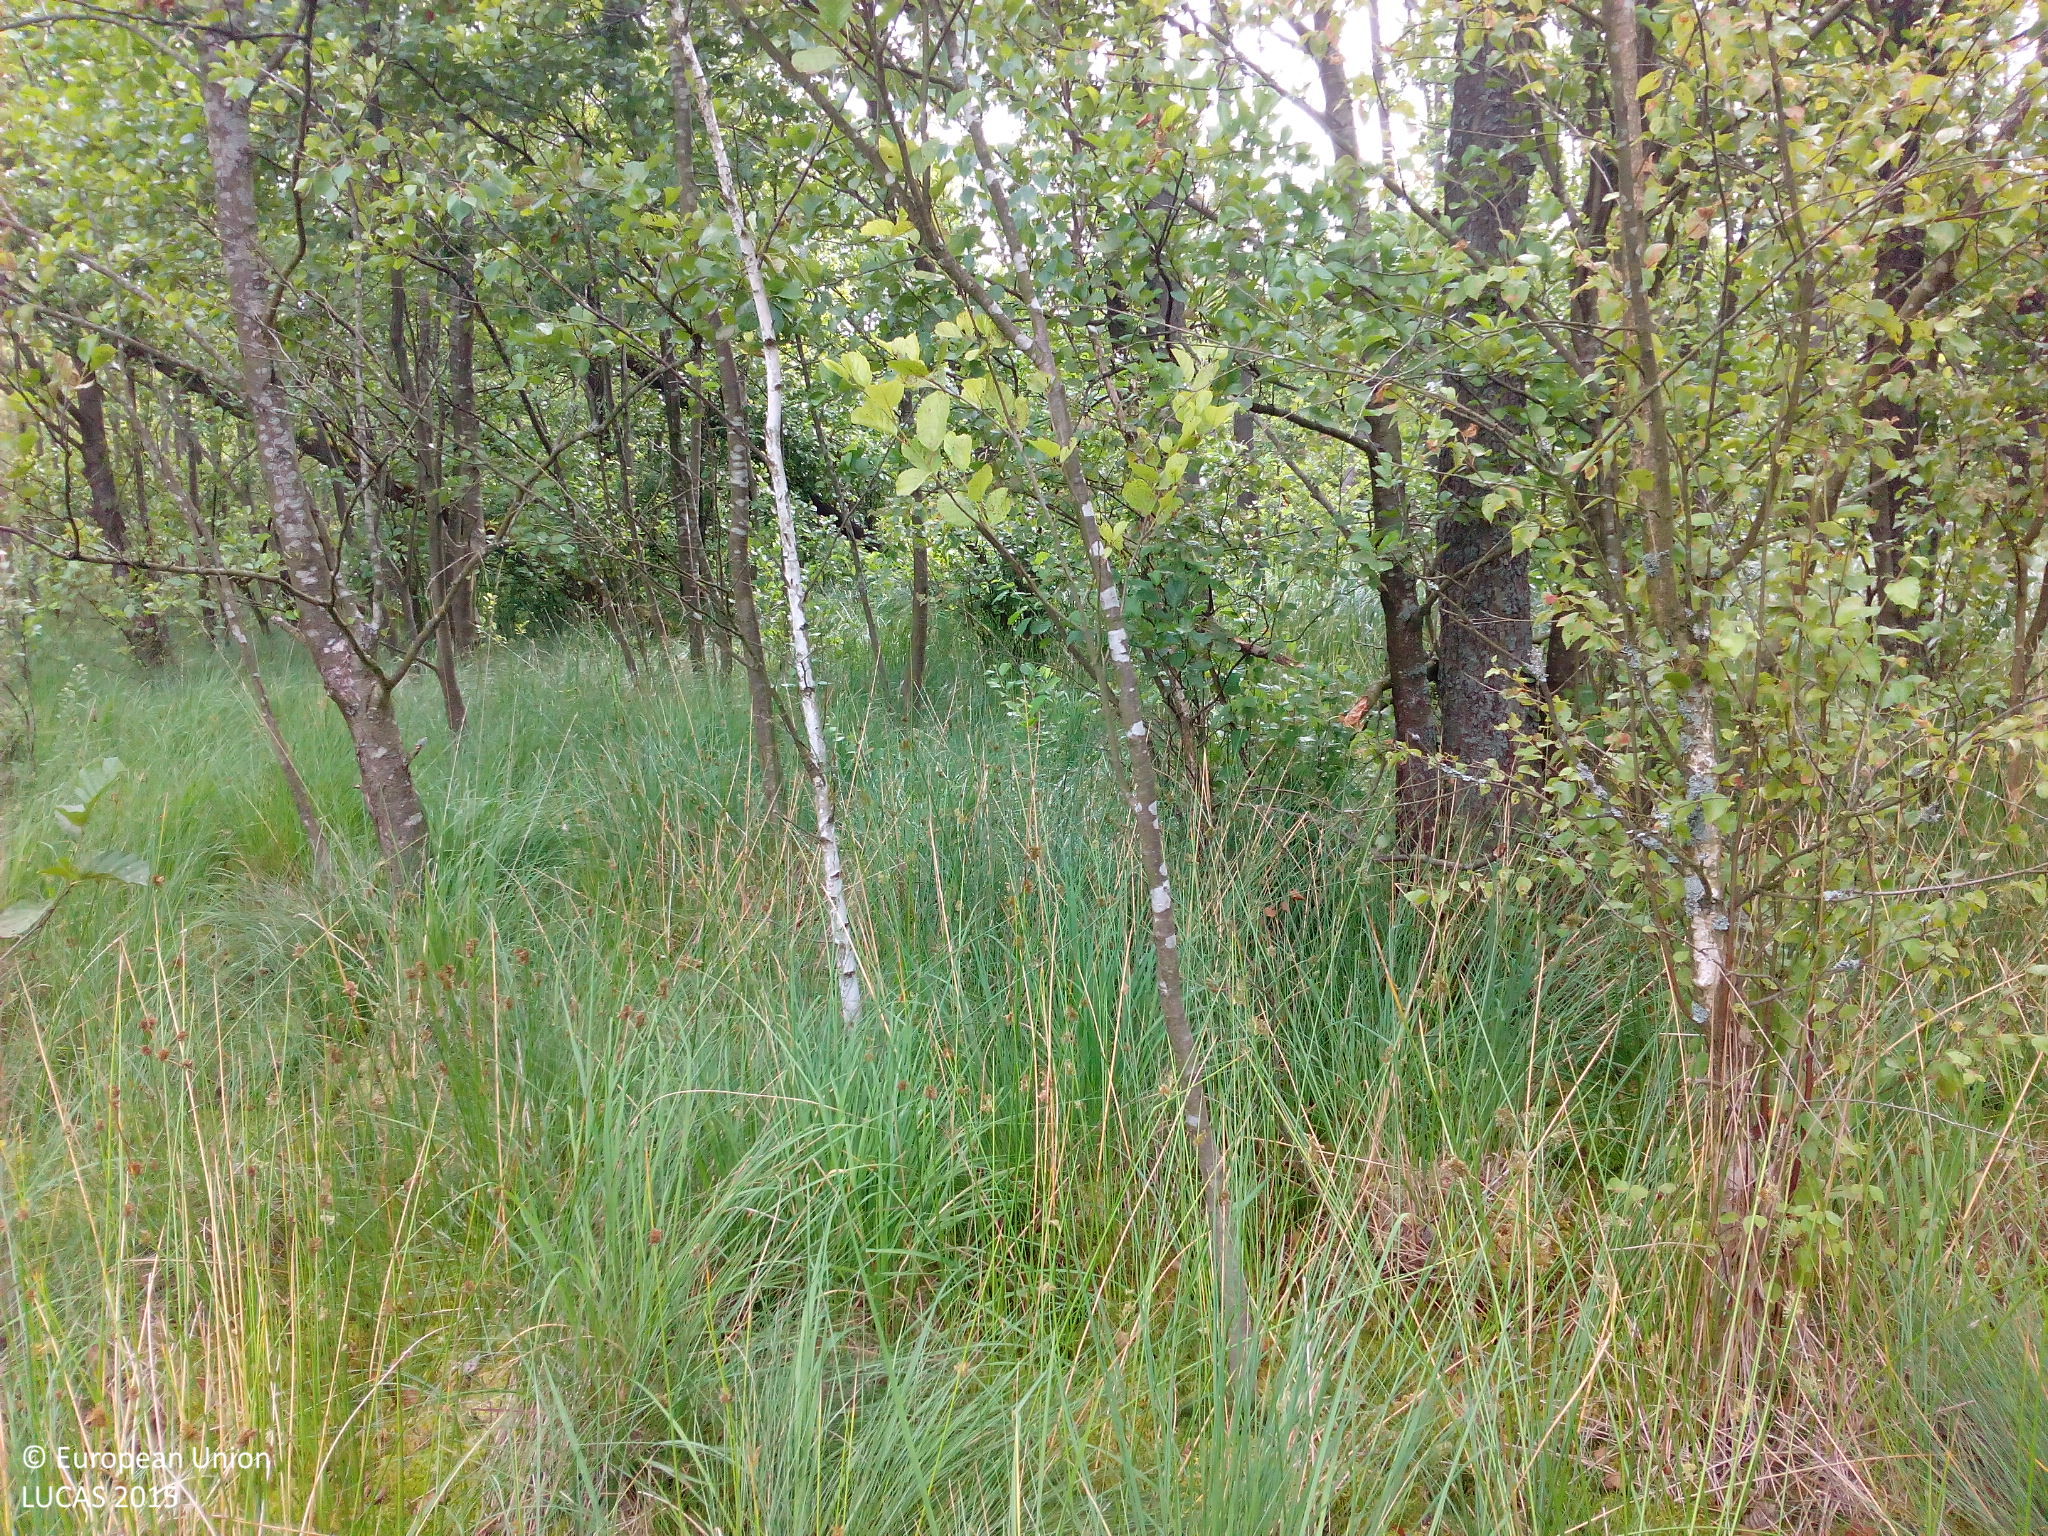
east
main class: Woodland
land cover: Broadleaved woodland
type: mesophytic deciduous forest
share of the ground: 25 - 50 %
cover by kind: broadleaved forest trees 30 %, herbaceous plants 30 %, shrubs 20 %, lichens and mosses 20 %
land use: Semi-natural and natural areas not in use
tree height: > 5 m
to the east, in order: Broadleaved woodland; Inland fresh water bodies
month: July
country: DE
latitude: 53.5595
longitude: 14.3033
